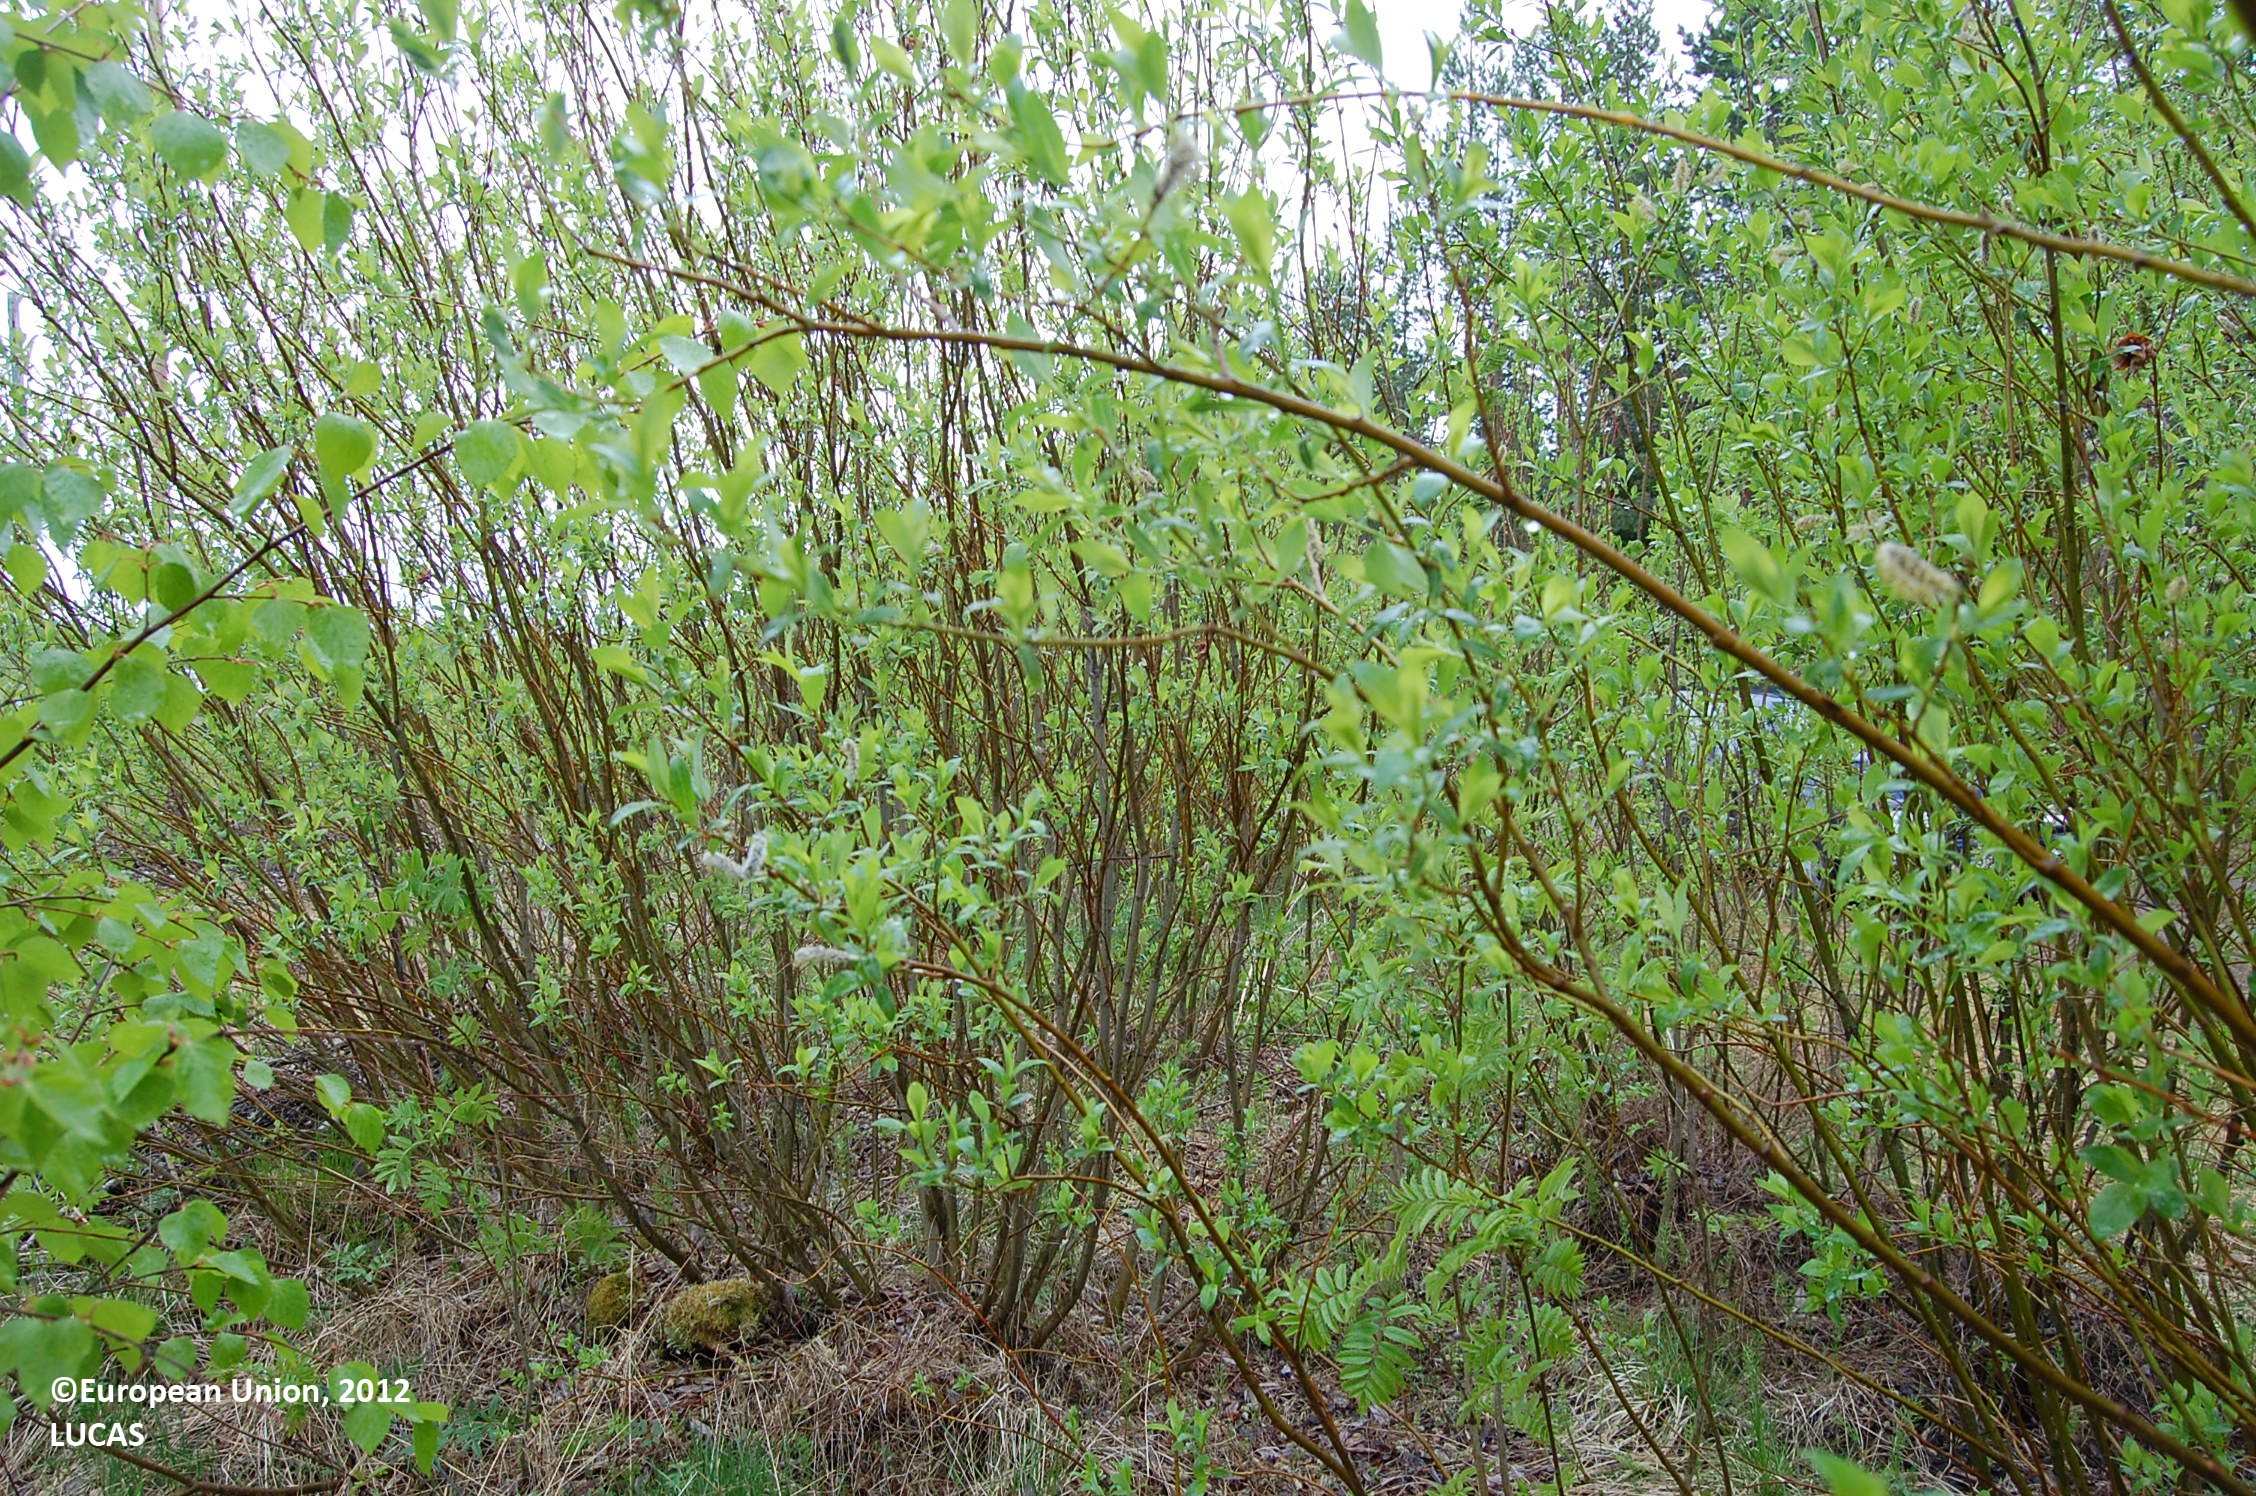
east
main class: Shrubland
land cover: Shrubland without tree cover
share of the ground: > 75 %
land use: Semi-natural and natural areas not in use
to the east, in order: Shrubland without tree cover; Paved roads, cycling and walking lanes; Ditches and canals; Other mixed woodland; Pine dominated mixed woodland; Ditches and canals; Grassland without tree/shrub cover; Abandoned hedges; Ditches and canals; Abandoned hedges; Grassland without tree/shrub cover; Abandoned hedges; Ditches and canals; Abandoned hedges; Grassland without tree/shrub cover; Ditches and canals; Grass margins; Paved roads, cycling and walking lanes; Grass margins; Pine dominated mixed woodland; Ditches and canals; Pine dominated mixed woodland
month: June
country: FI
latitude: 64.1119
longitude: 27.4094
